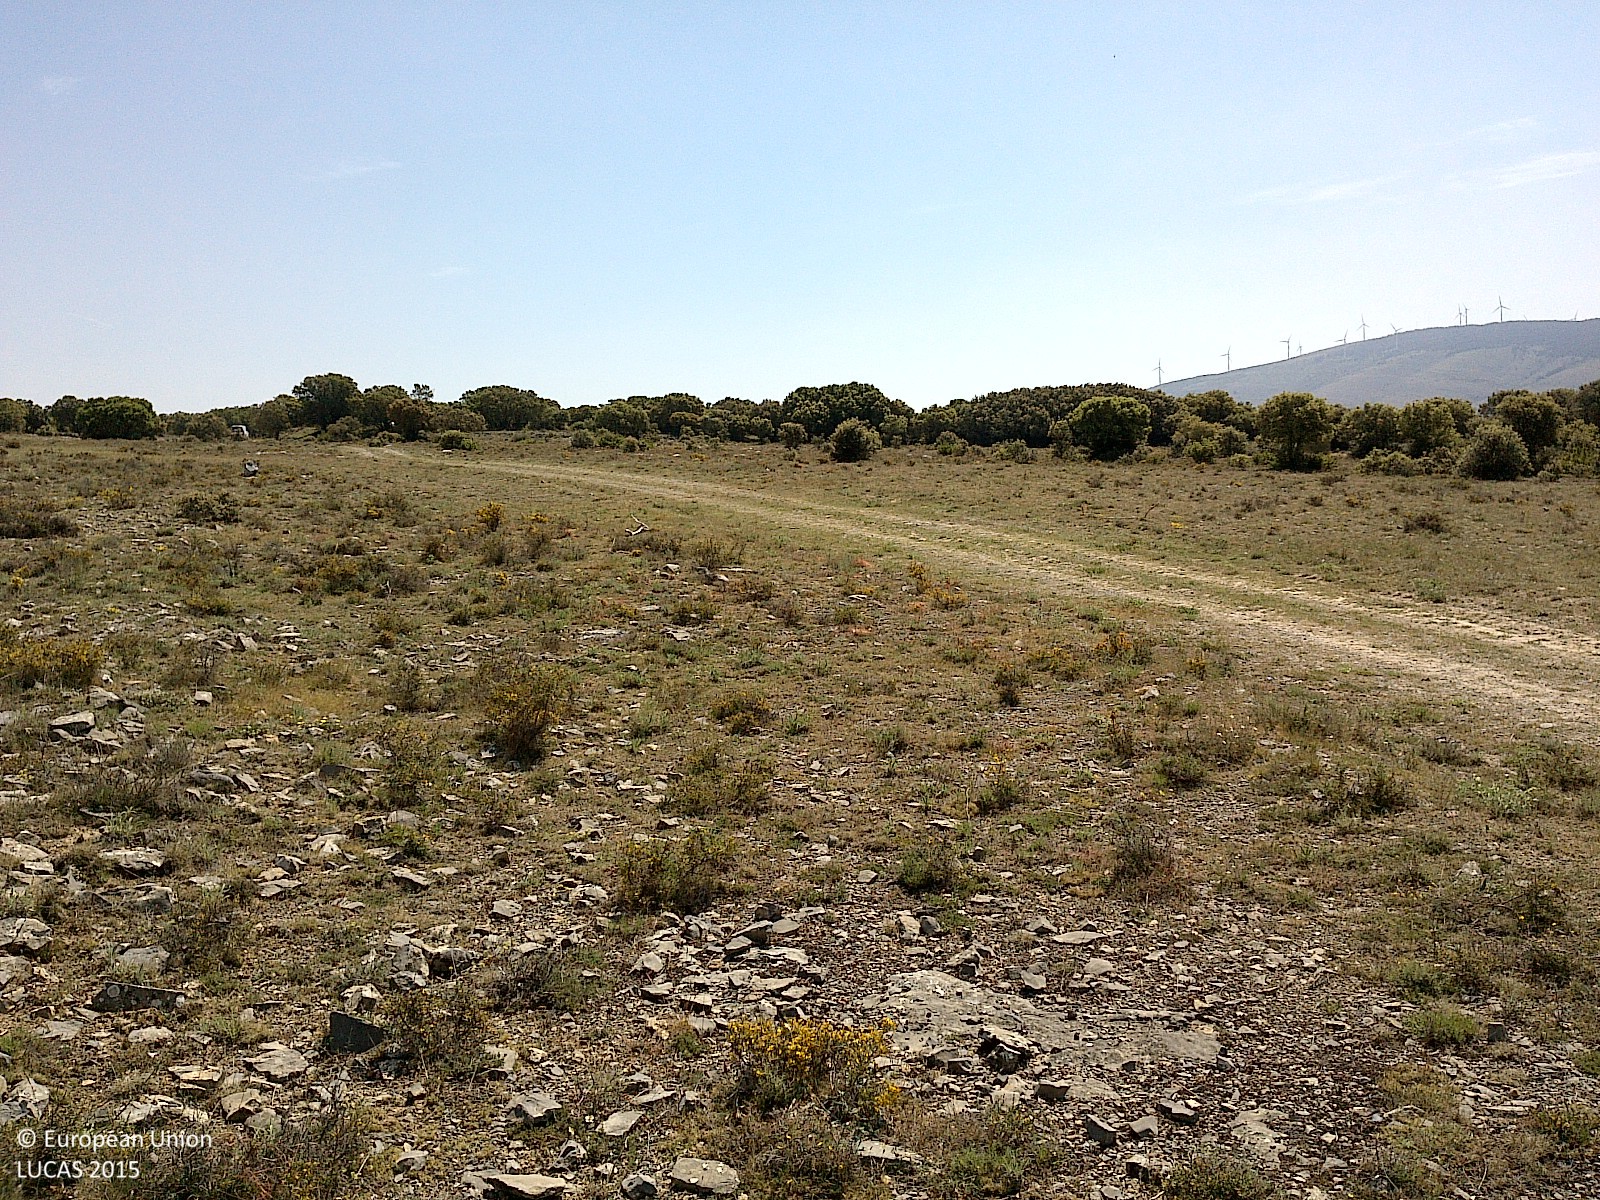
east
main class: Grassland
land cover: Grassland without tree/shrub cover
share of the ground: > 75 %
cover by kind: herbaceous plants 80 %, consolidated bare surface 15 %, shrubs 5 %
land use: Semi-natural and natural areas not in use
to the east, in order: Grassland without tree/shrub cover; Tracks; Grassland without tree/shrub cover; Broadleaved woodland
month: May
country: ES
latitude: 41.8631
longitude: -2.3131
